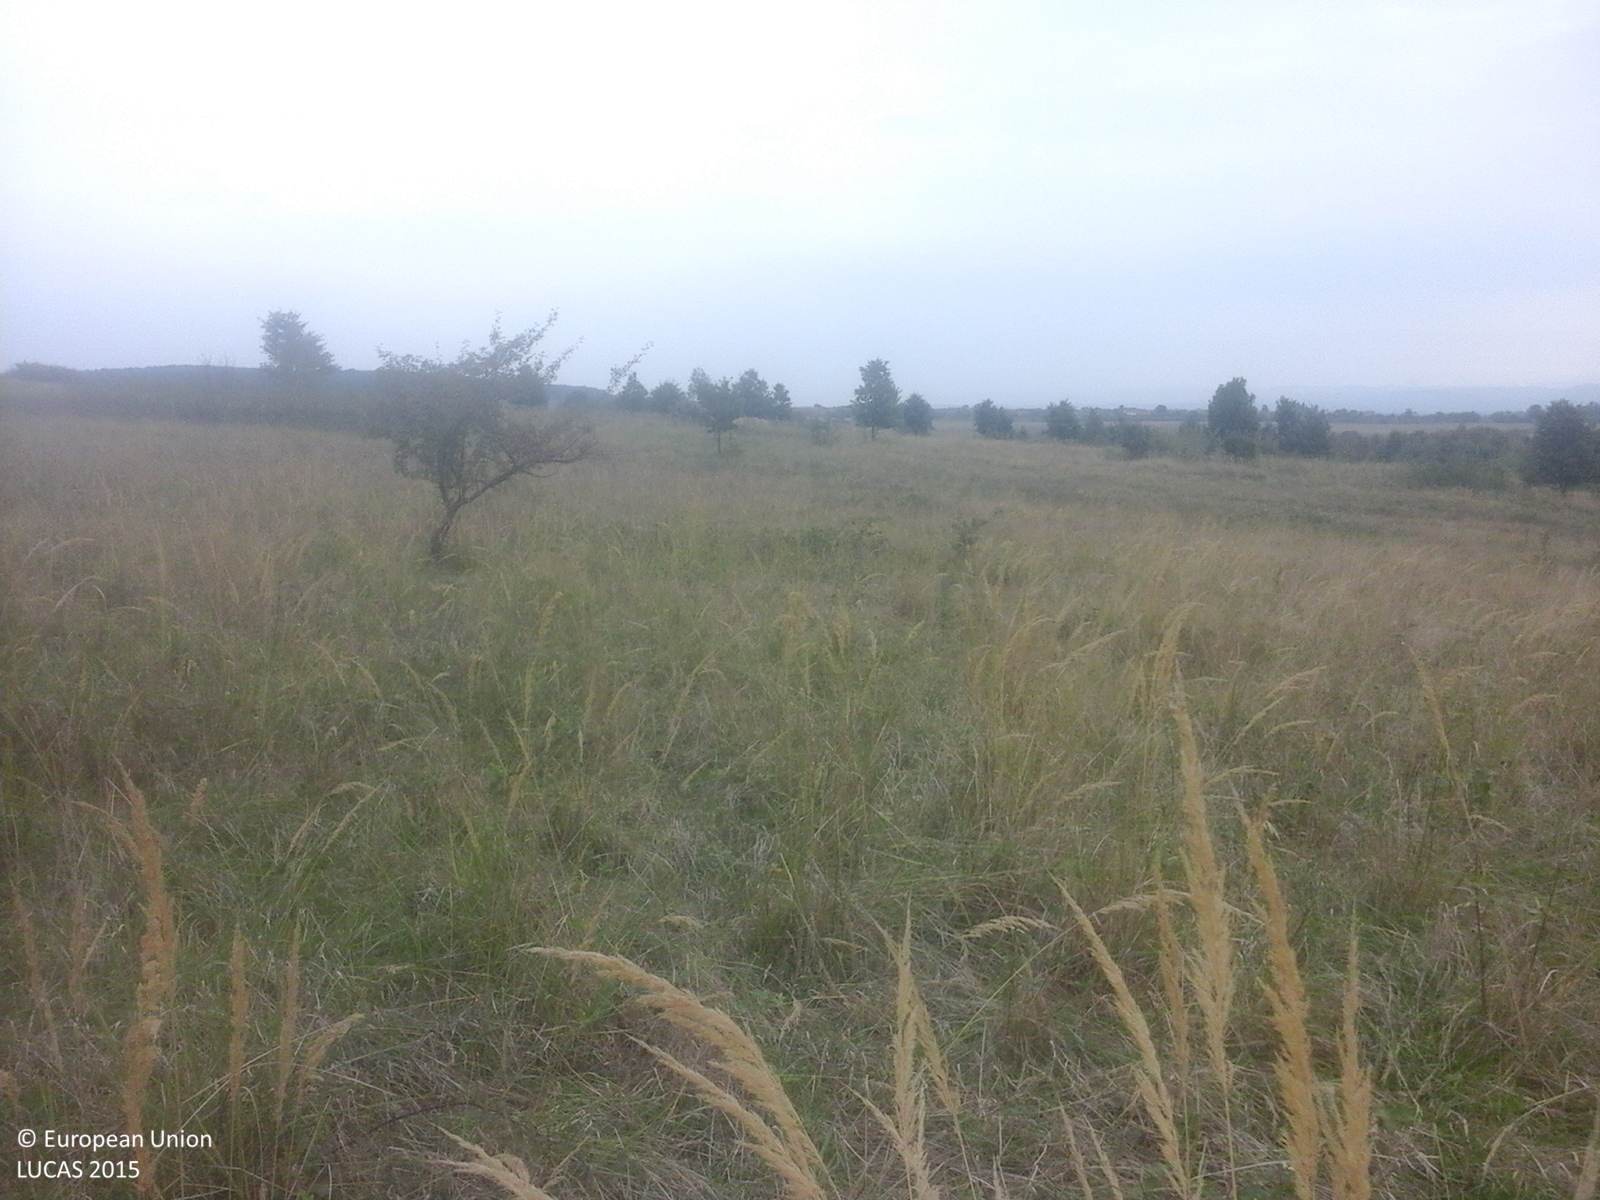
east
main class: Grassland
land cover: Grassland with sparse tree/shrub cover
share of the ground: > 75 %
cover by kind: herbaceous plants 85 %, shrubs 10 %, broadleaved forest trees 5 %
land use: Agriculture (excluding fallow land and kitchen gardens)
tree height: < 5 m
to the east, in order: Grassland with sparse tree/shrub cover; Grassland without tree/shrub cover; Grassland with sparse tree/shrub cover; Tracks; Grassland with sparse tree/shrub cover; Tracks; Spontaneously vegetated surfaces; Ditches and canals; Abandoned hedges; Spontaneously vegetated surfaces
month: September
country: RO
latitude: 45.8605
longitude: 22.1108
